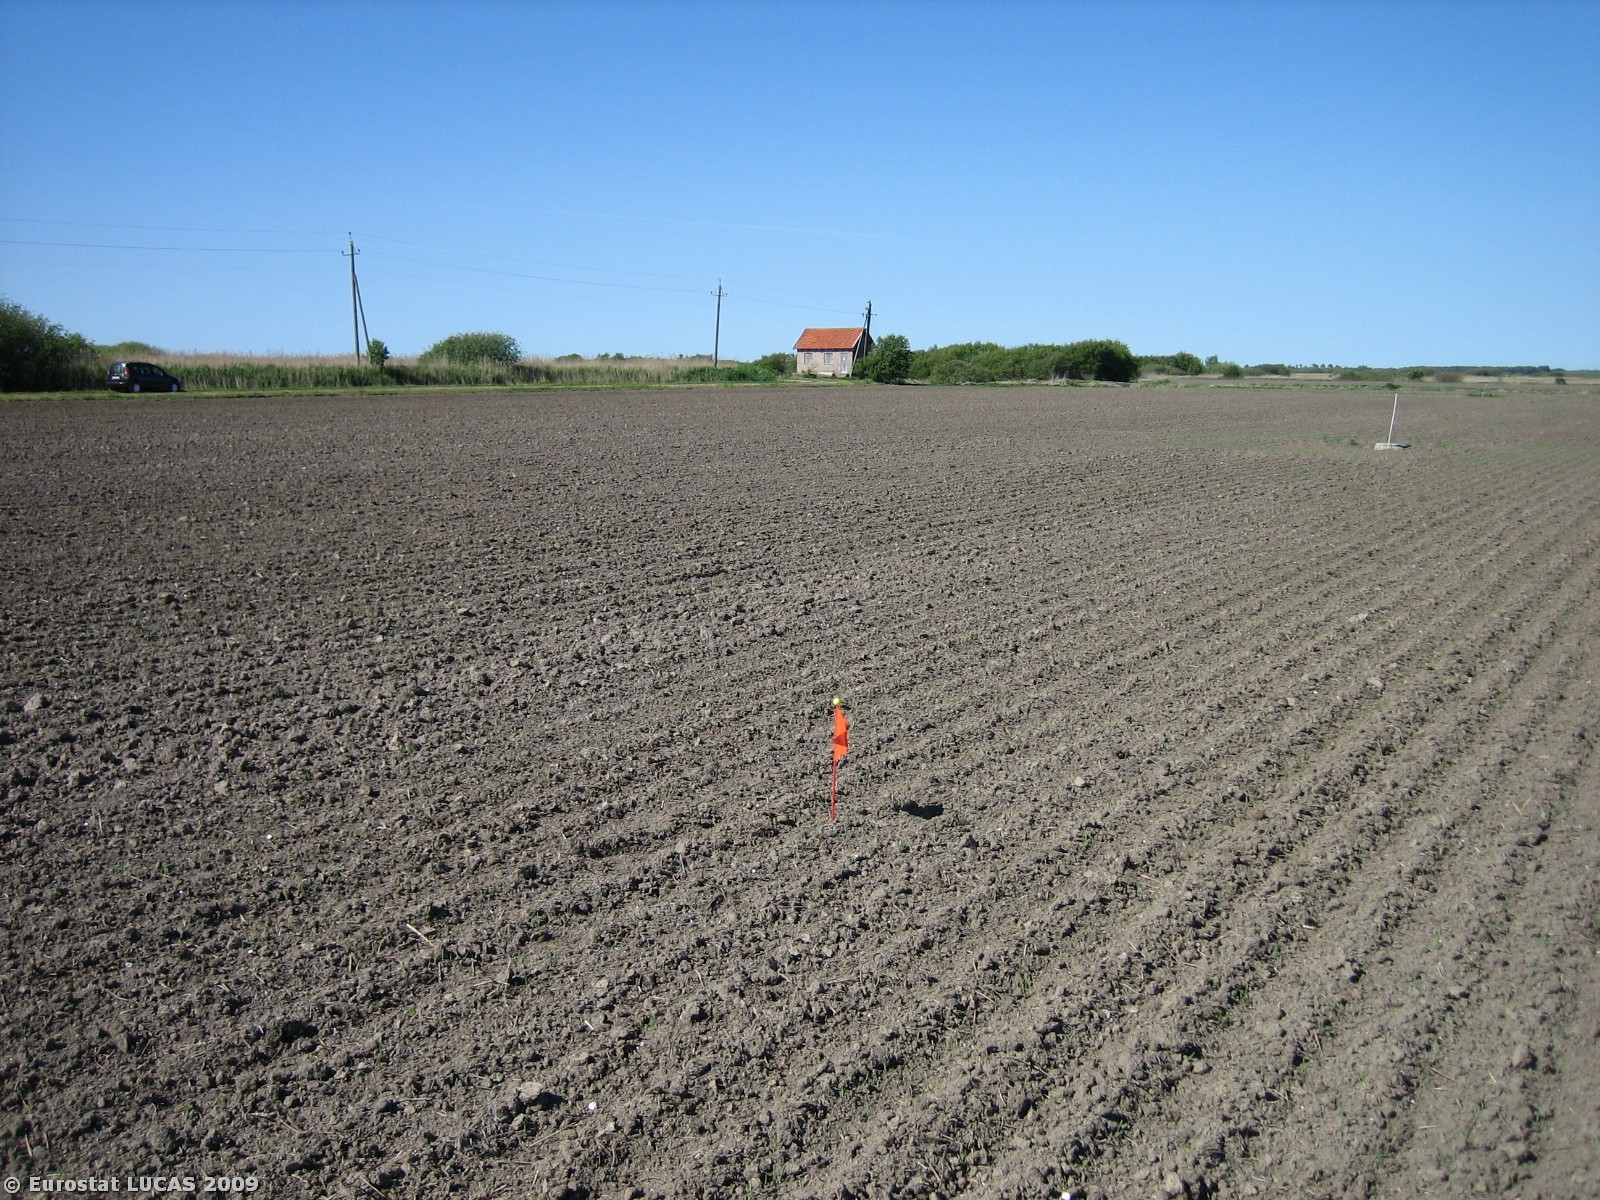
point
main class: Cropland
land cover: Barley
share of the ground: < 10 %
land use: Agriculture (excluding fallow land and kitchen gardens)
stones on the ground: < 10 %
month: May
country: DK
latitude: 56.2472
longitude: 8.2107
